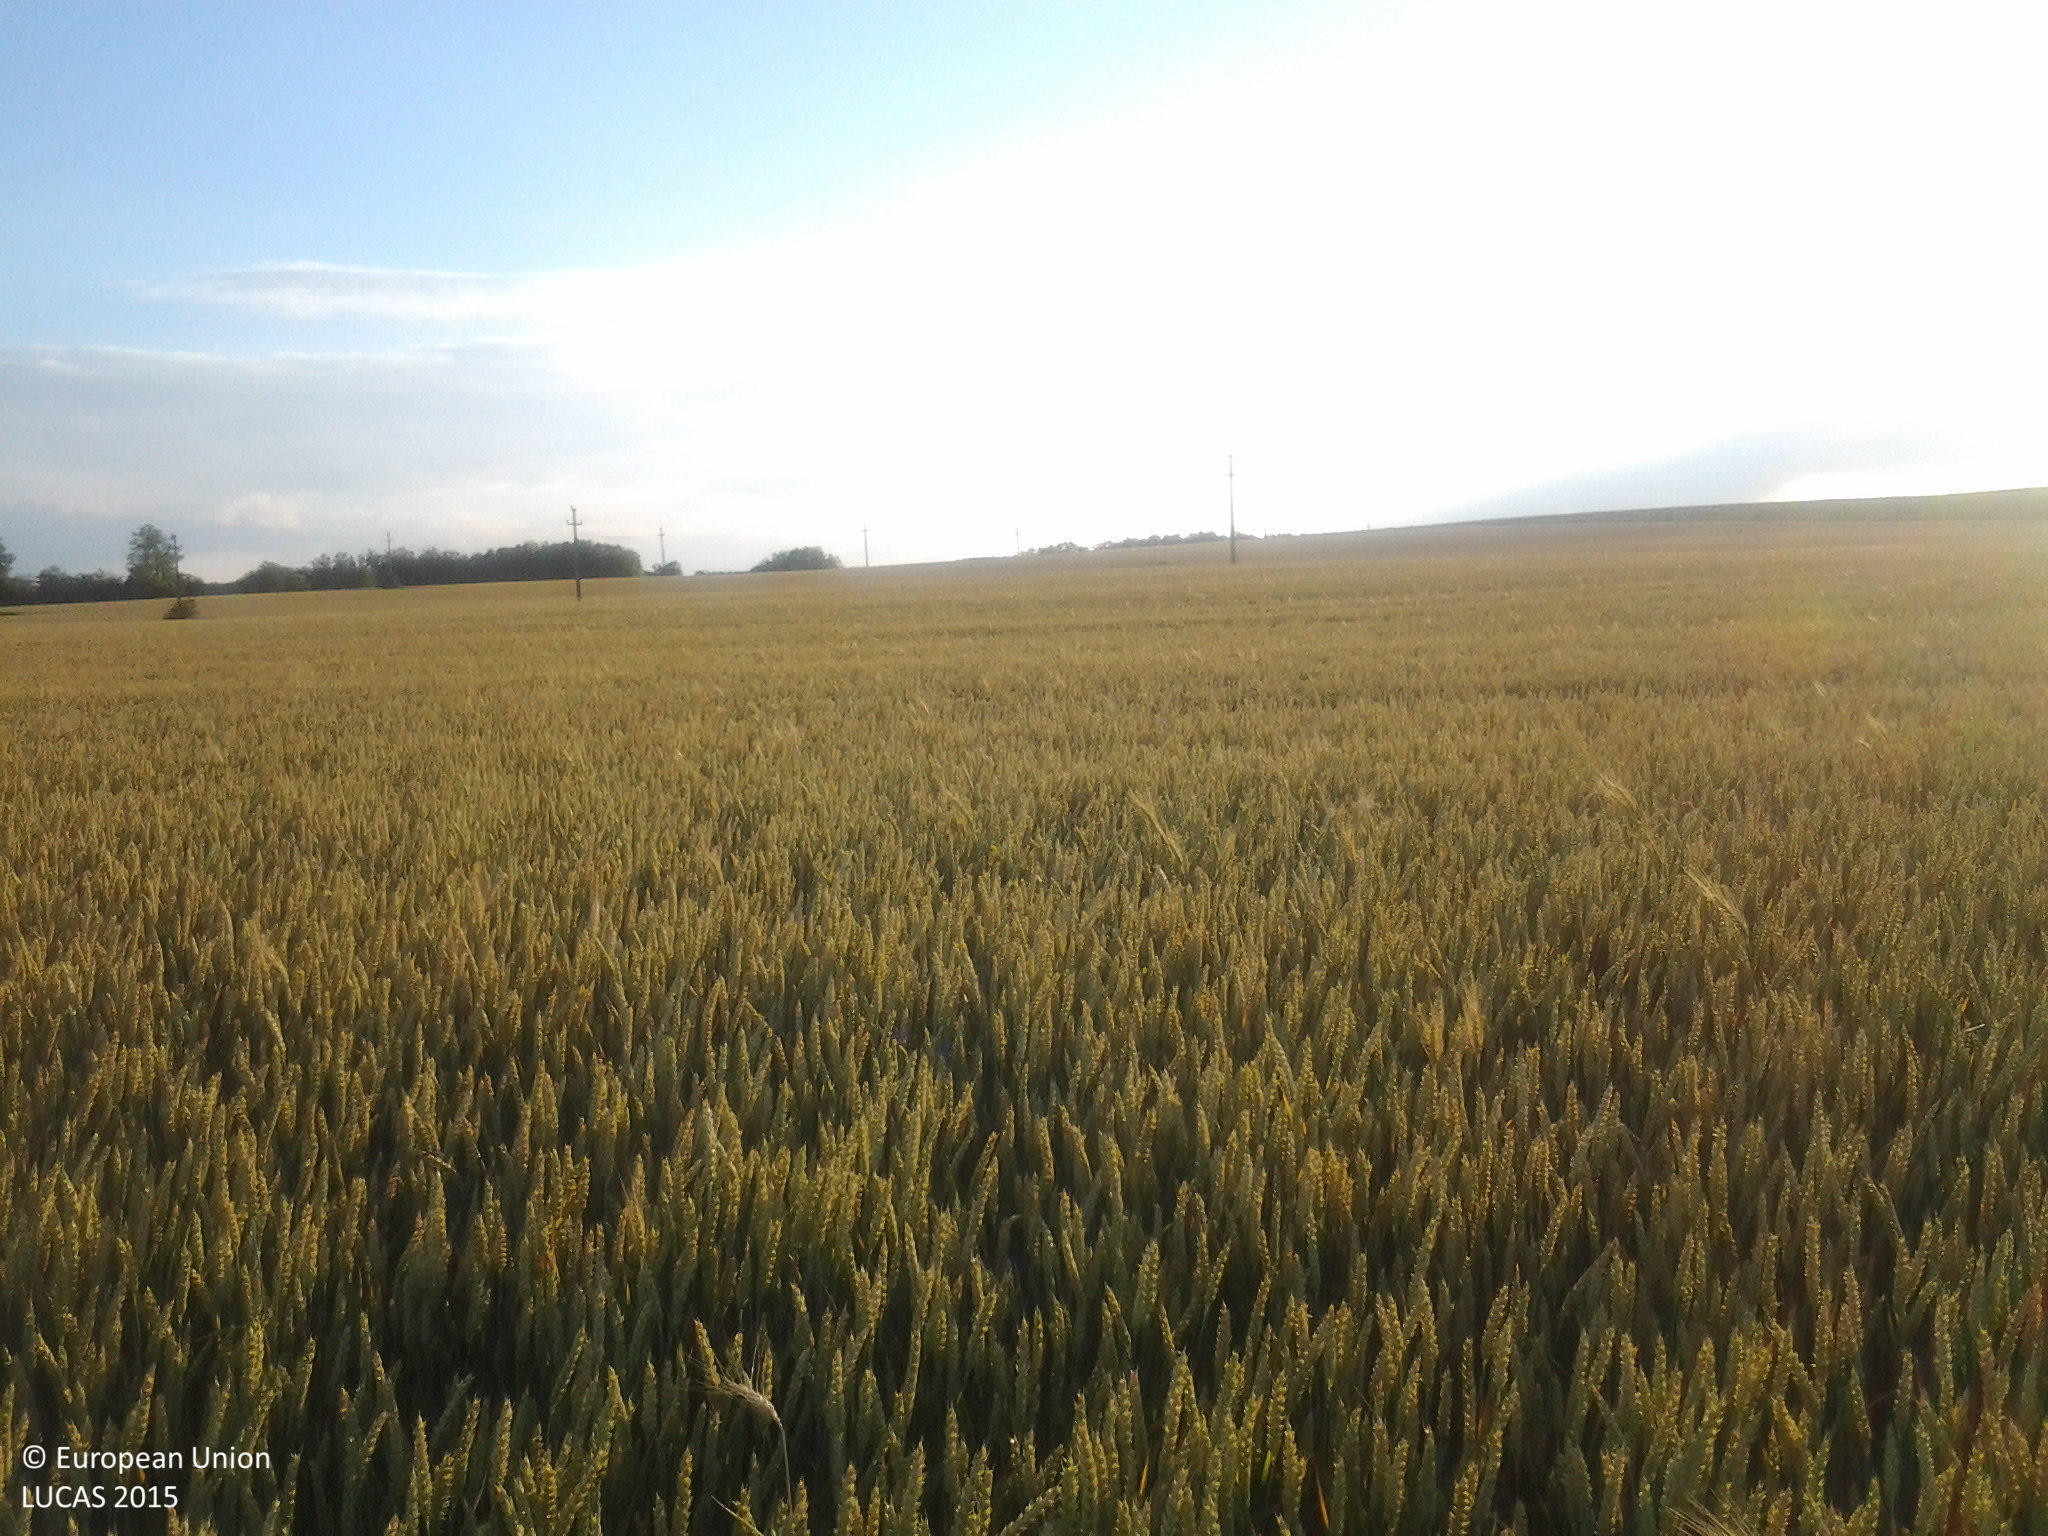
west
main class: Cropland
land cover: Common wheat
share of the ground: > 75 %
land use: Agriculture (excluding fallow land and kitchen gardens)
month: June
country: RO
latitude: 46.8950
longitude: 27.4240
